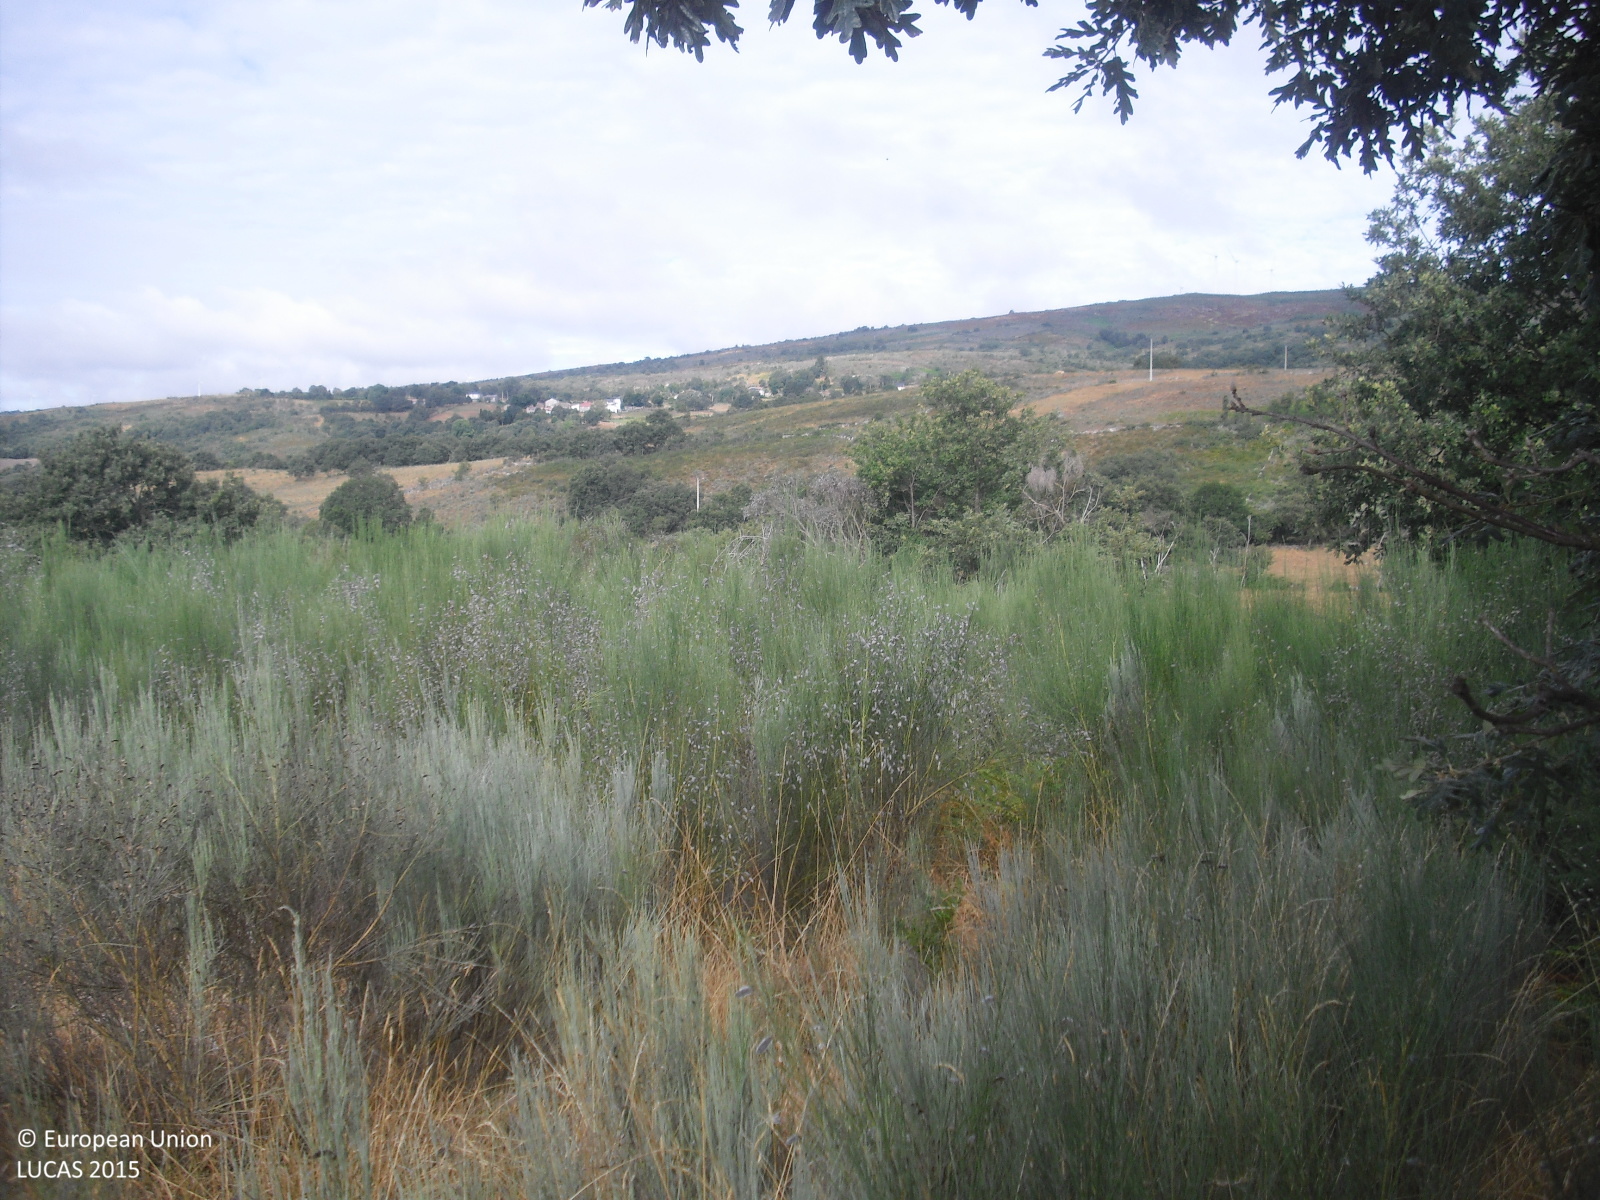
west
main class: Shrubland
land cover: Shrubland with sparse tree cover
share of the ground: > 75 %
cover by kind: shrubs 65 %, herbaceous plants 30 %, broadleaved forest trees 5 %
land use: Abandoned areas
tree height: < 5 m
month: July
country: ES
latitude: 42.3177
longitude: -7.3777
